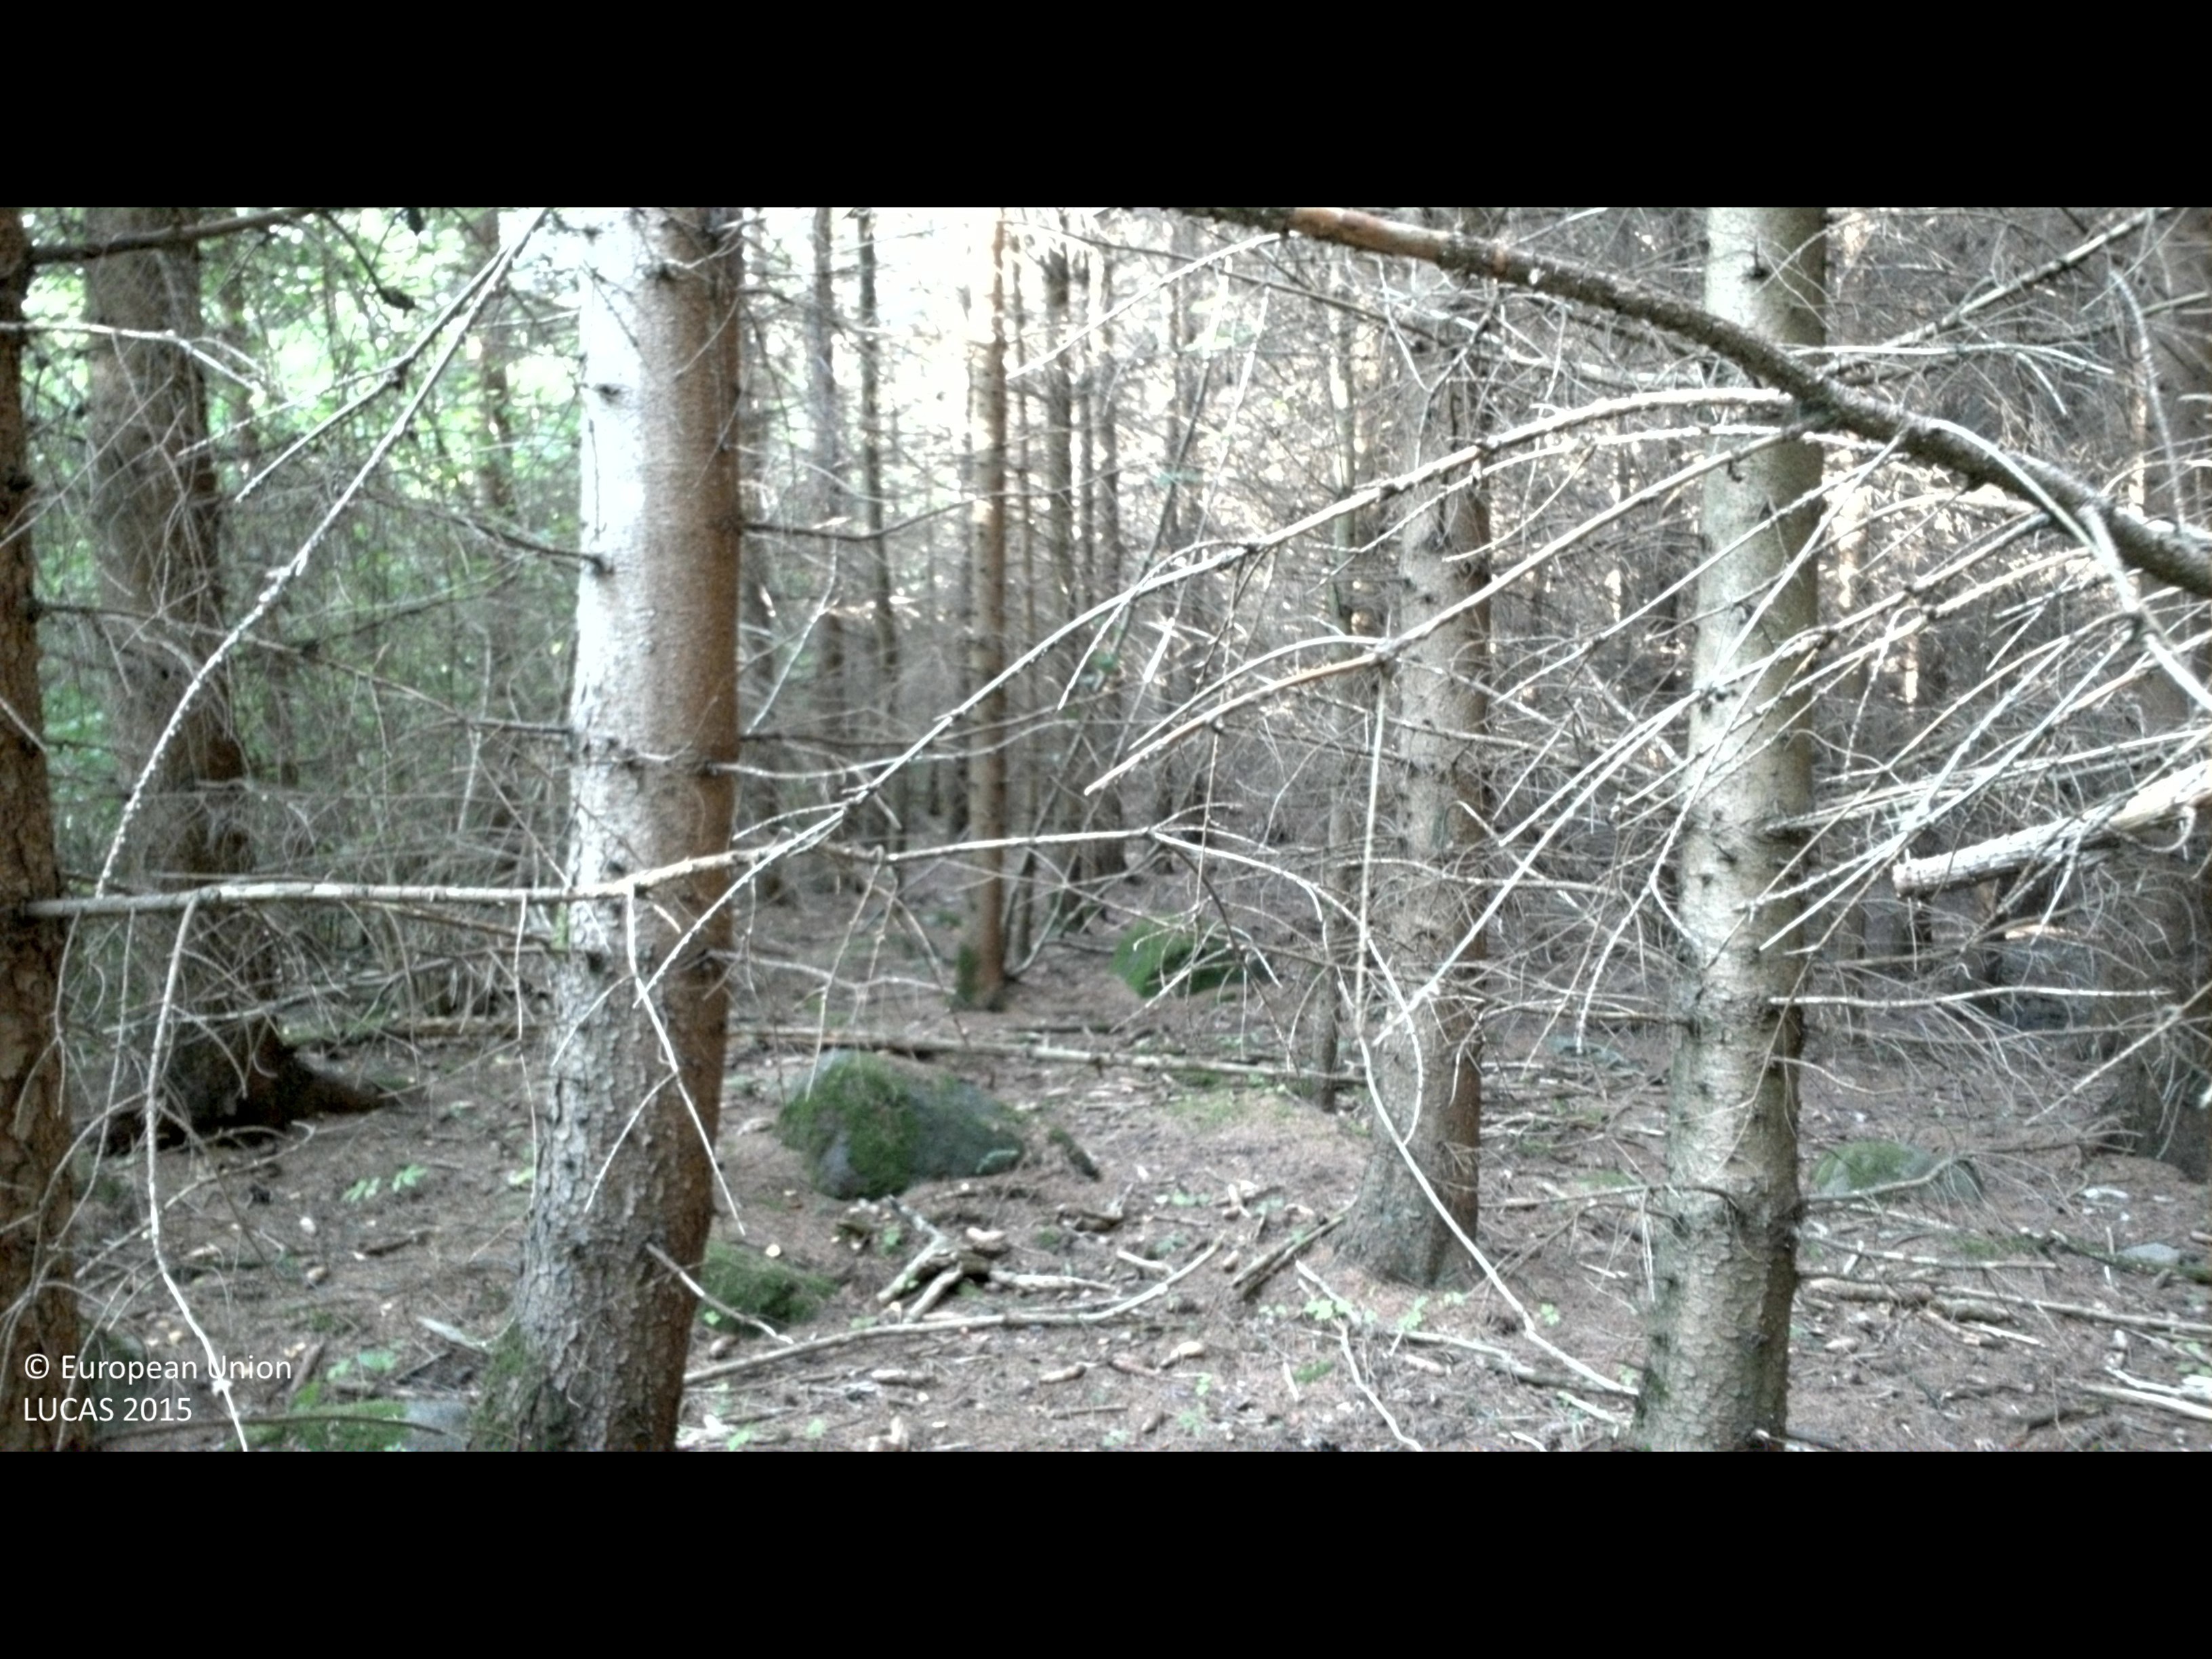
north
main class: Woodland
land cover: Spruce dominated coniferous woodland
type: boreal forest
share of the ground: > 75 %
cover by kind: coniferous forest trees 90 %, lichens and mosses 5 %, unconsolidated bare surface 5 %
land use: Forestry
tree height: > 5 m
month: September
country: SE
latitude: 56.1351
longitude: 14.2620
